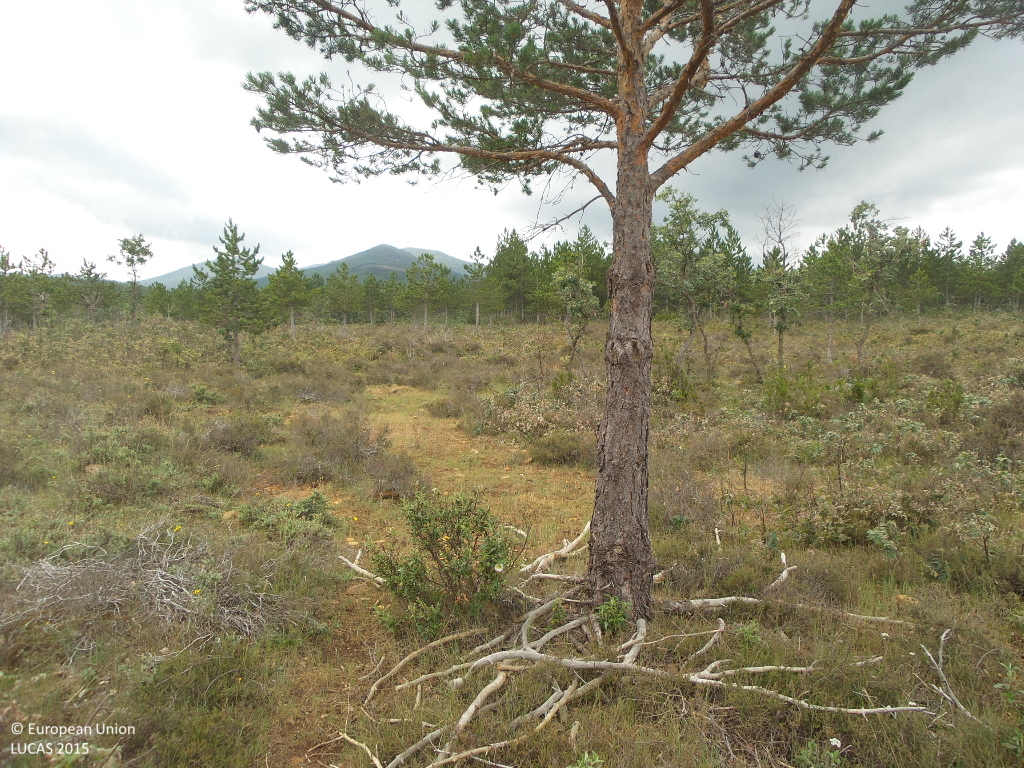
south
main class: Shrubland
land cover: Shrubland with sparse tree cover
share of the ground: > 75 %
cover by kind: shrubs 80 %, coniferous forest trees 5 %, herbaceous plants 5 %, lichens and mosses 5 %, unconsolidated bare surface 5 %
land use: Forestry
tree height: < 5 m
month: June
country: ES
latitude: 41.3153
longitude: -3.4361
